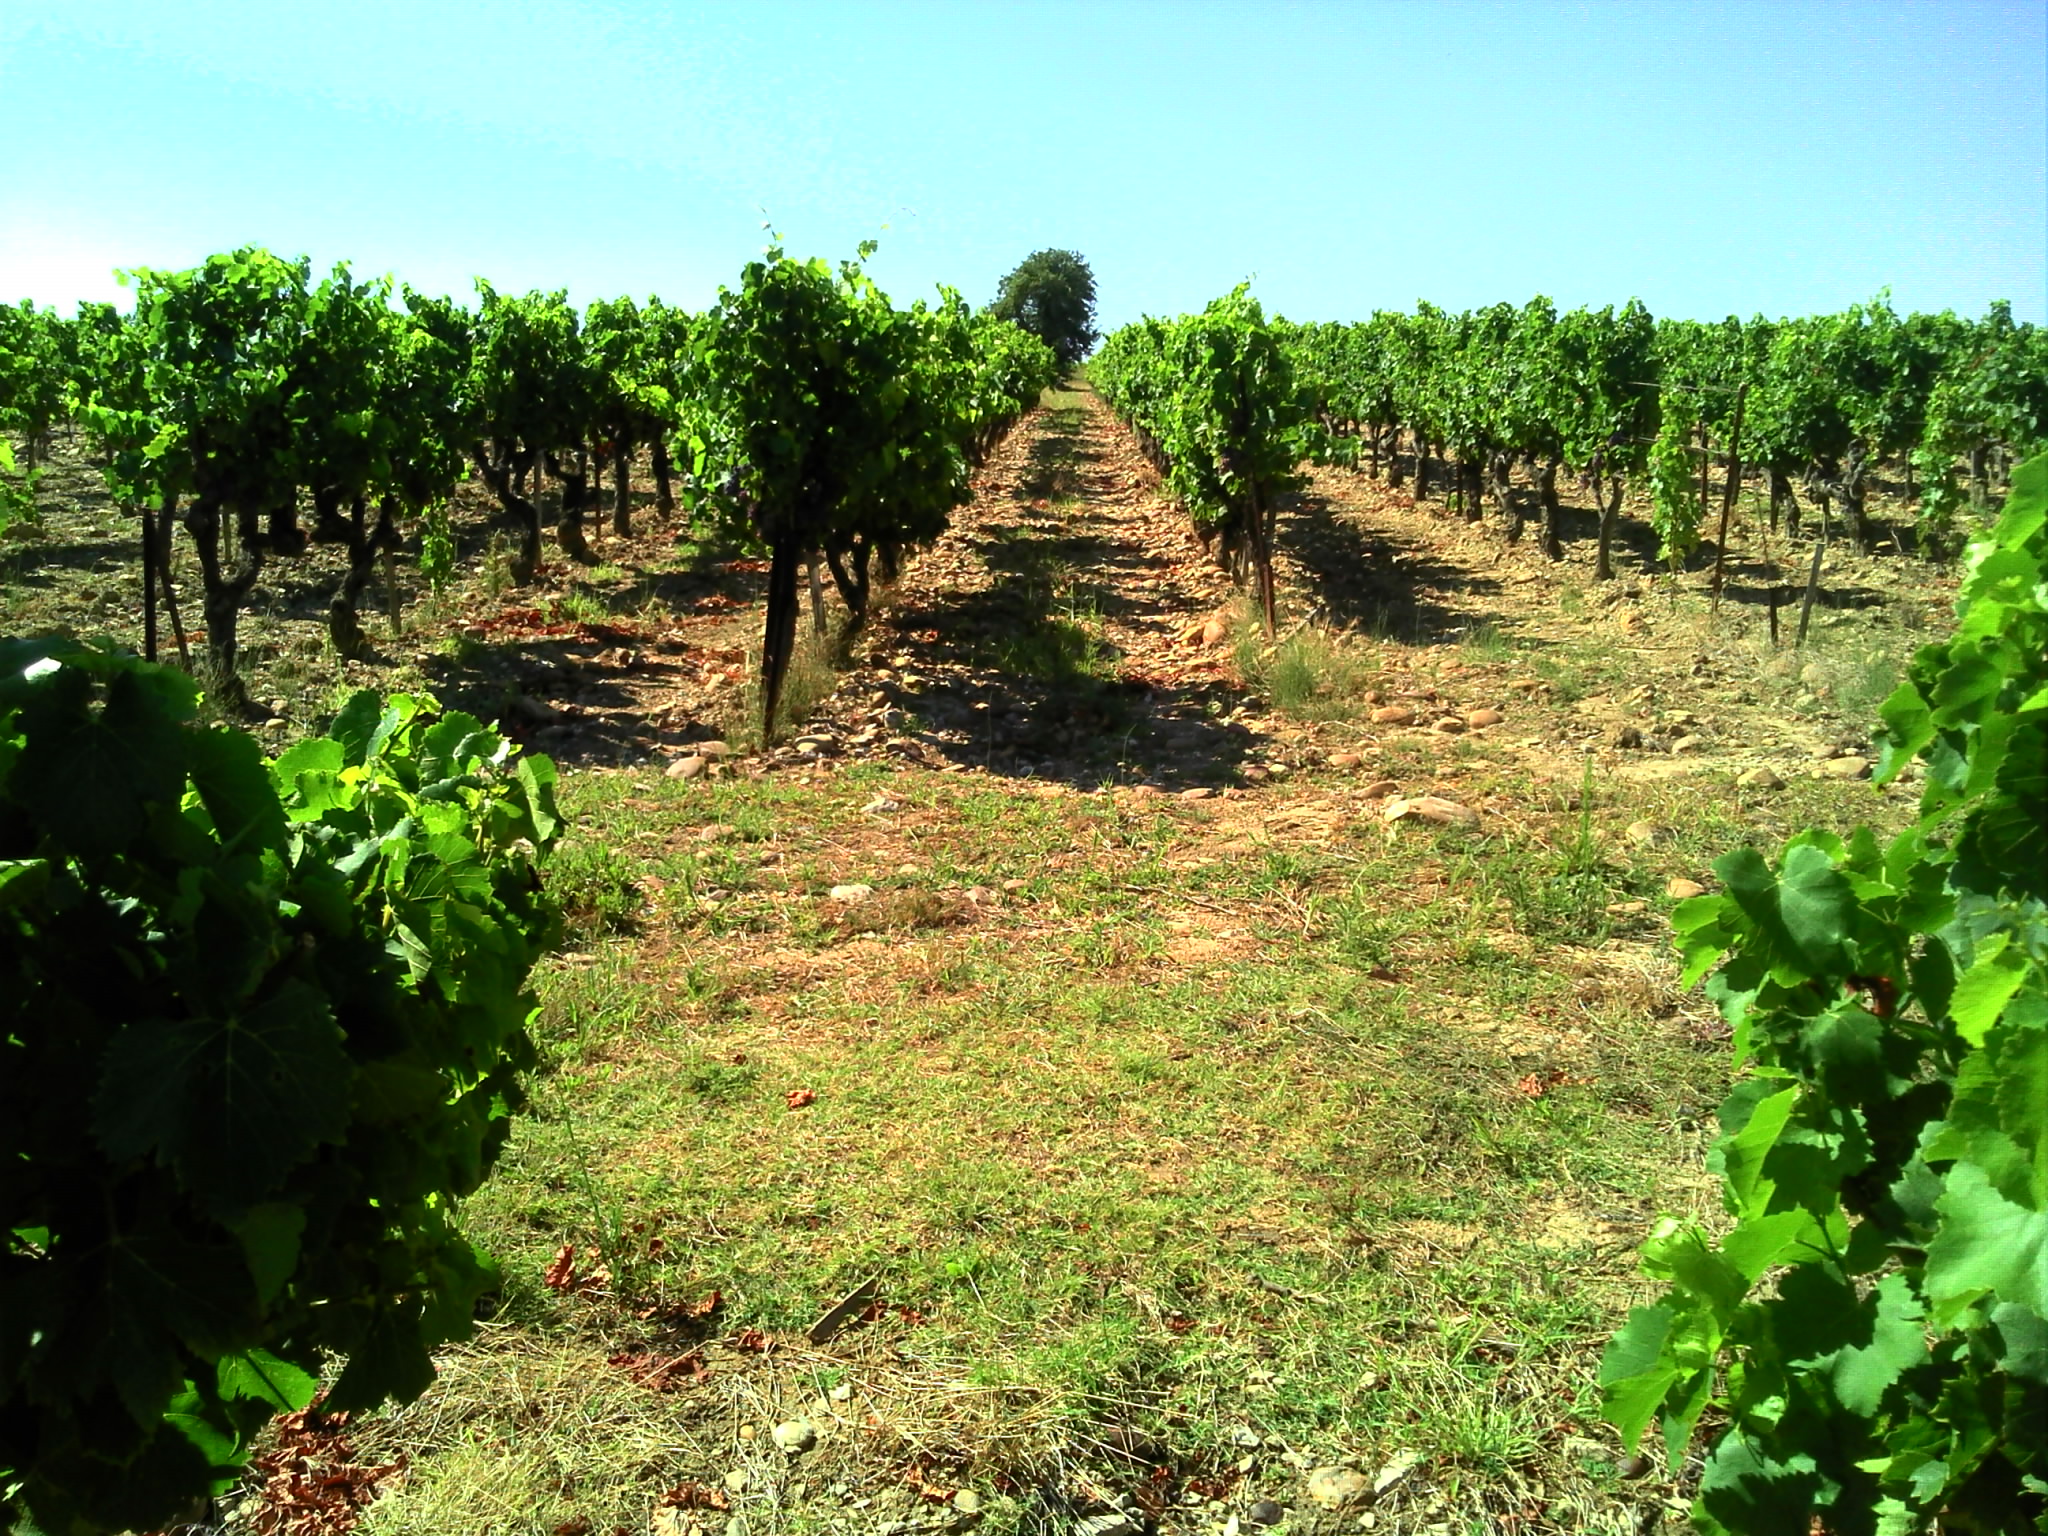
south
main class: Cropland
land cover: Vineyards
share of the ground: 25 - 50 %
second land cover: Other bare soil
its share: > 75 %
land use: Agriculture (excluding fallow land and kitchen gardens)
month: August
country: FR
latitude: 44.0706
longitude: 4.7017
